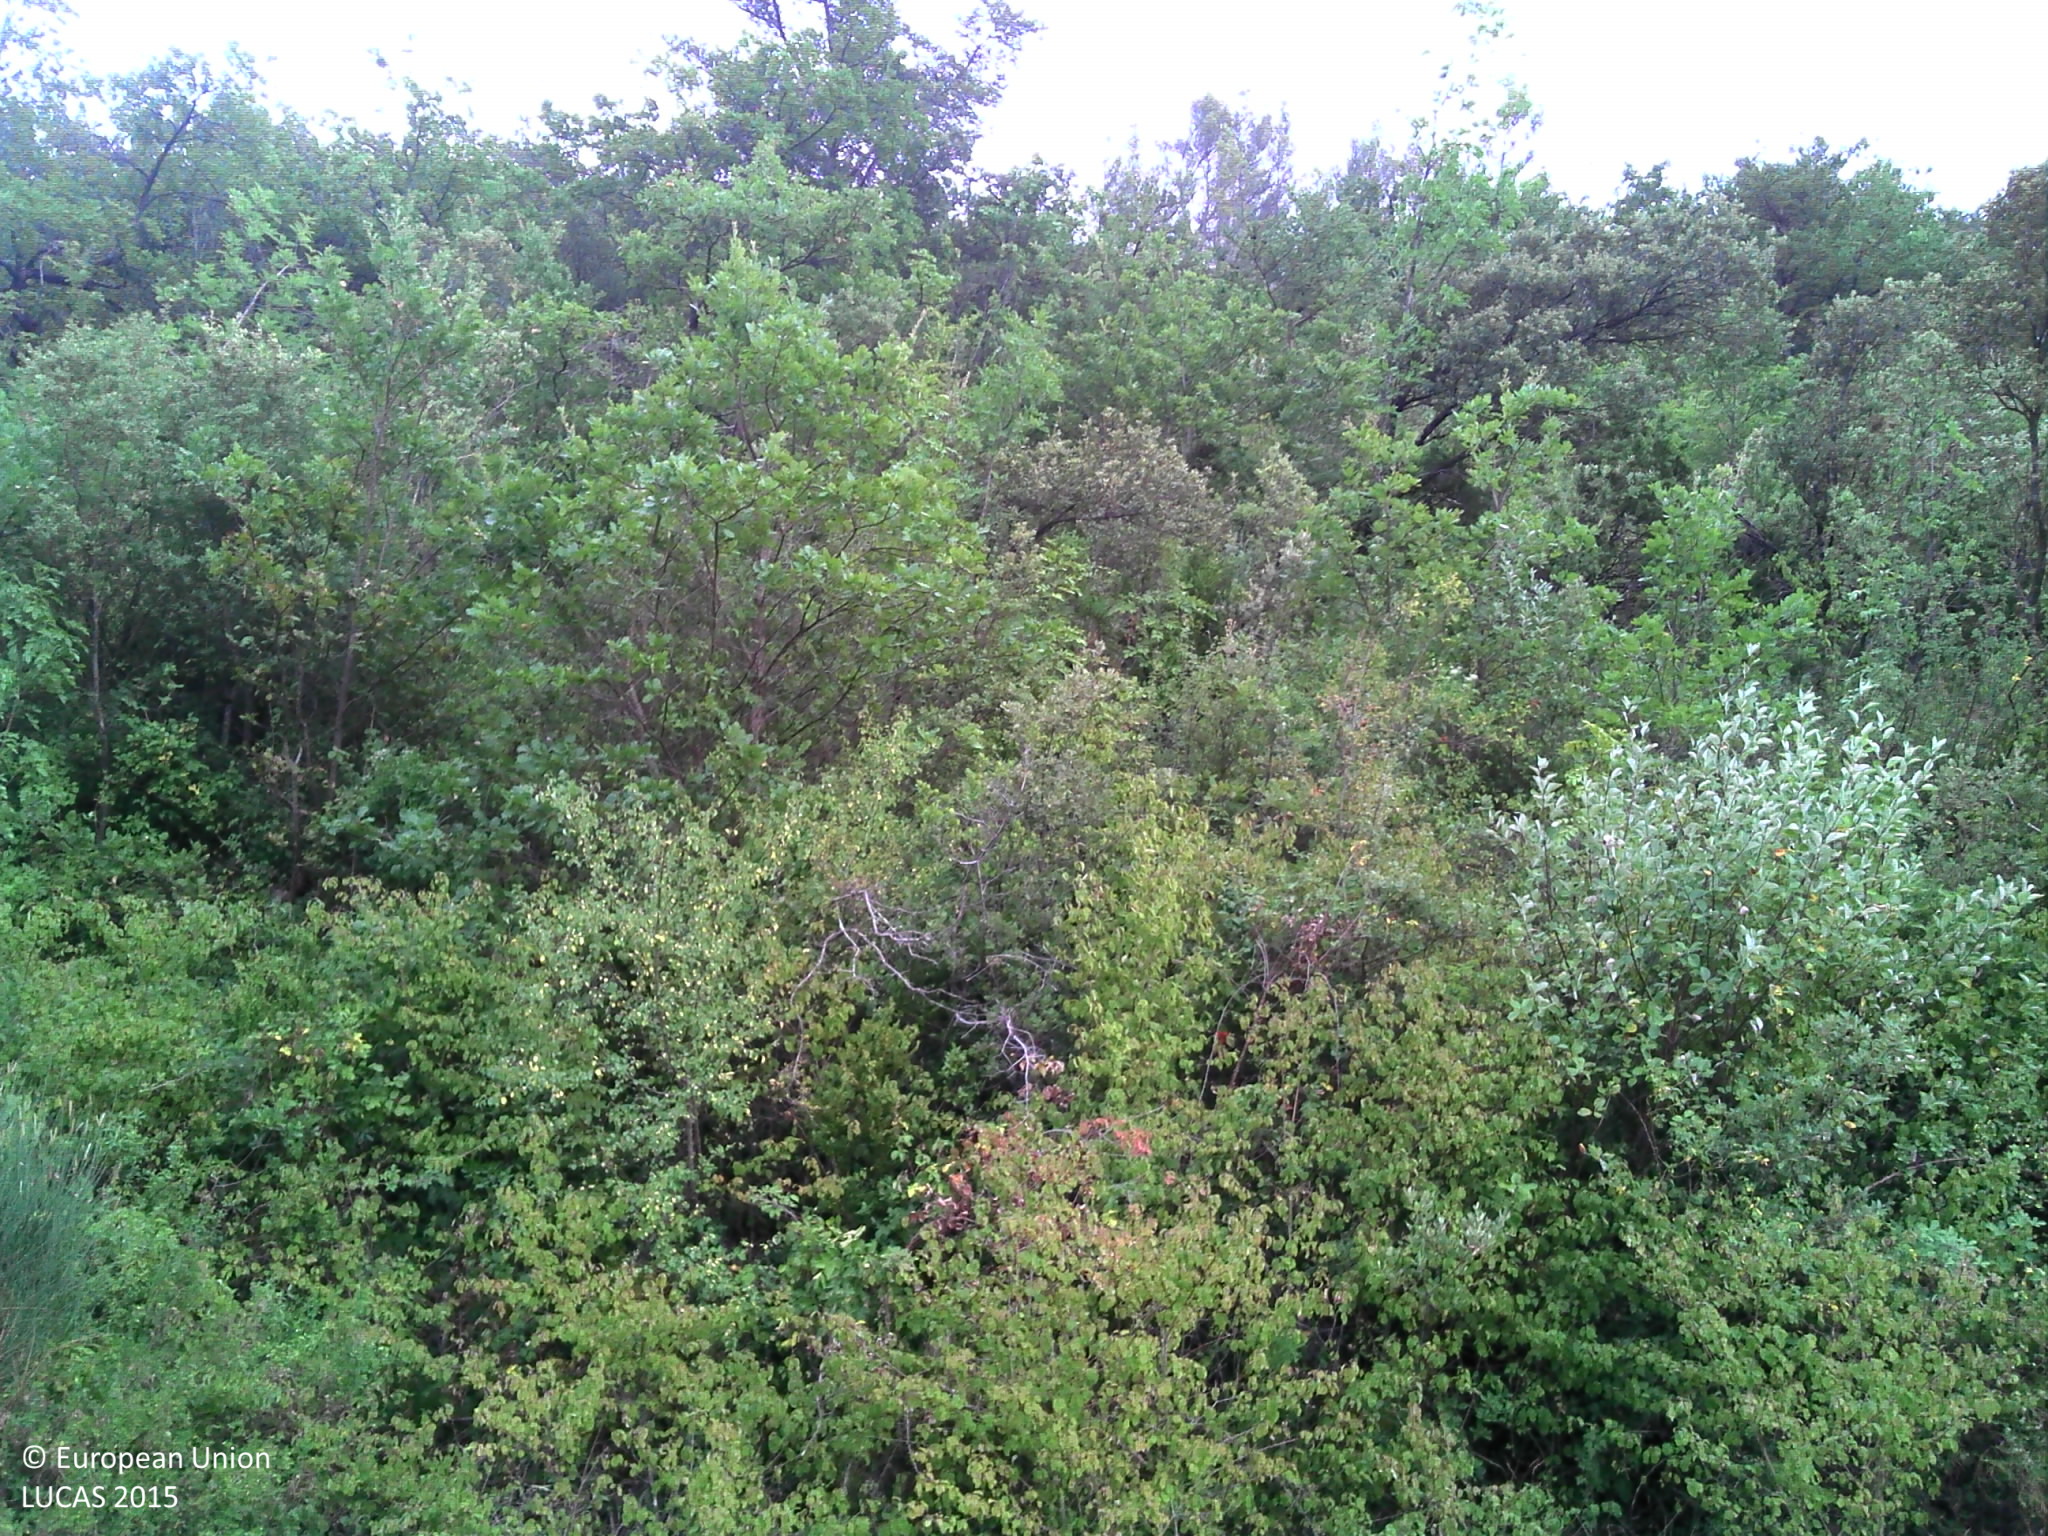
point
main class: Woodland
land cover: Broadleaved woodland
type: broadleaved evergreen forest
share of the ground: > 75 %
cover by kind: broadleaved forest trees 90 %, herbaceous plants 10 %
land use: Semi-natural and natural areas not in use
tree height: > 5 m
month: July
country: FR
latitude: 44.4817
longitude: 4.6130
